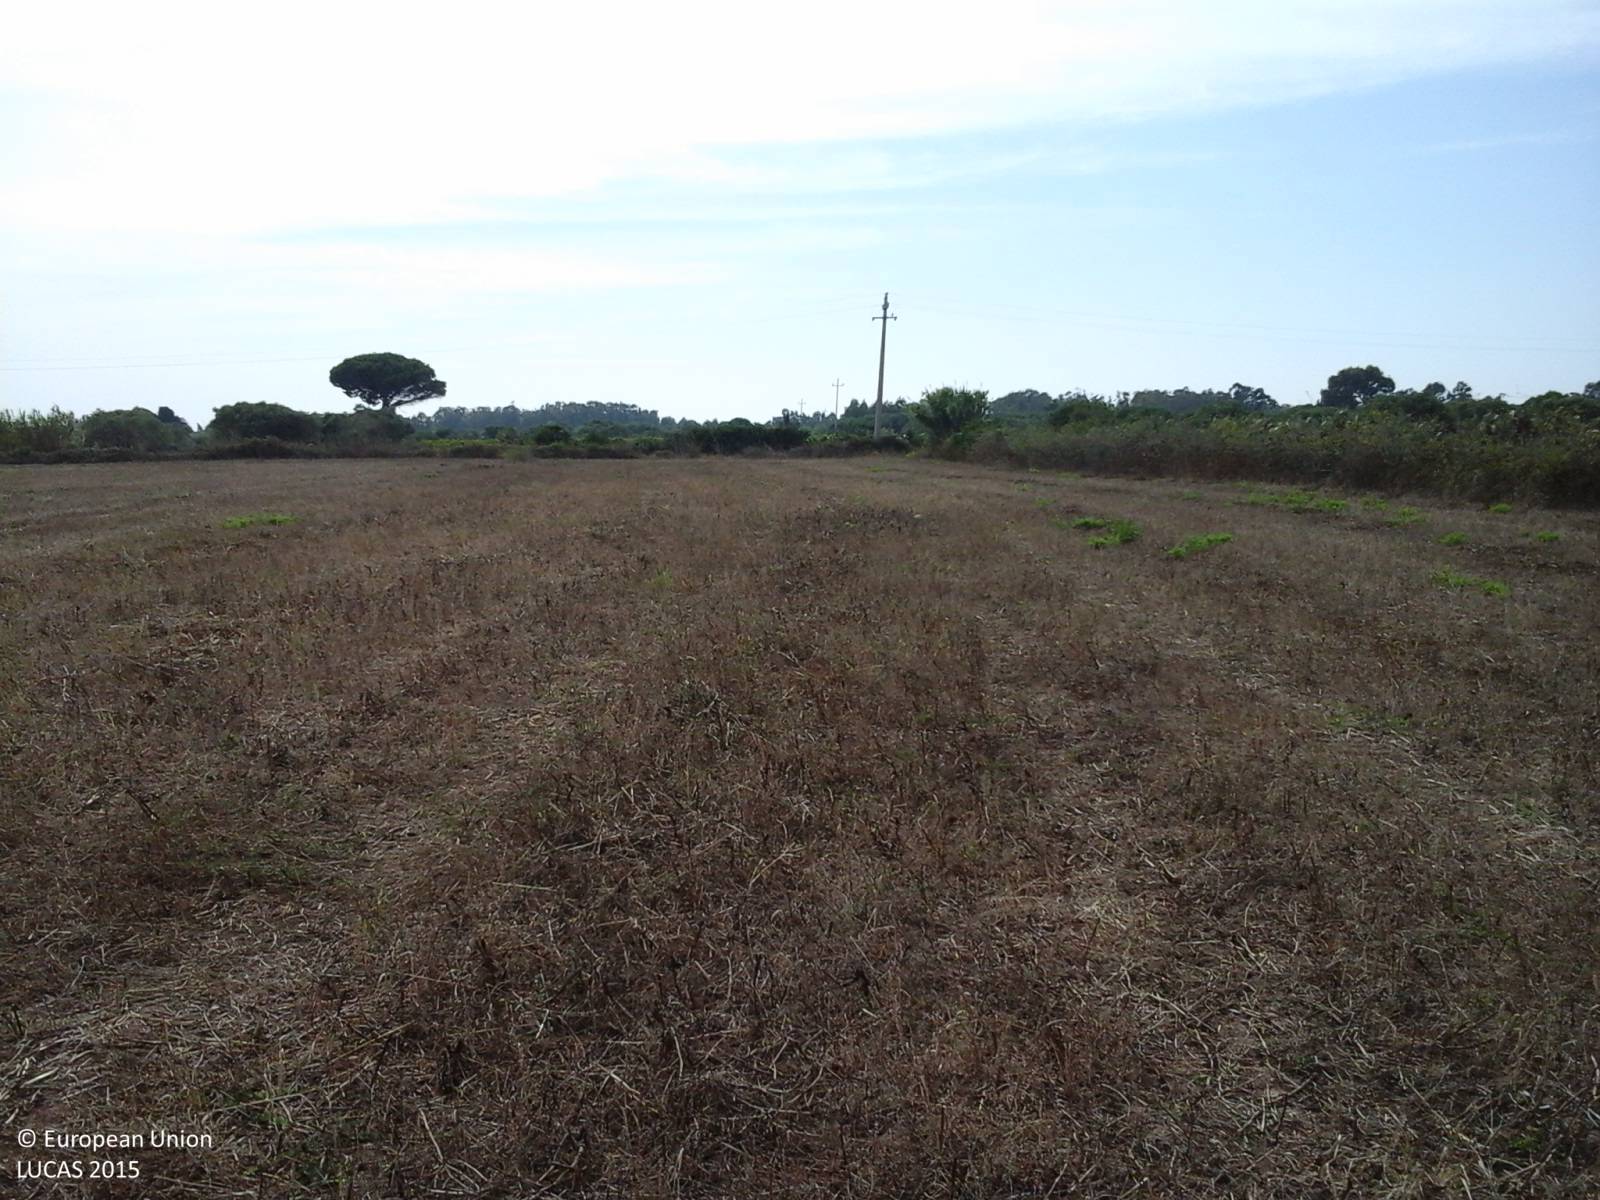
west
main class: Cropland
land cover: Temporary grasslands
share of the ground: > 75 %
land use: Agriculture (excluding fallow land and kitchen gardens)
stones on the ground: < 10 %
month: August
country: IT
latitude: 40.0208
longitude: 8.5200
